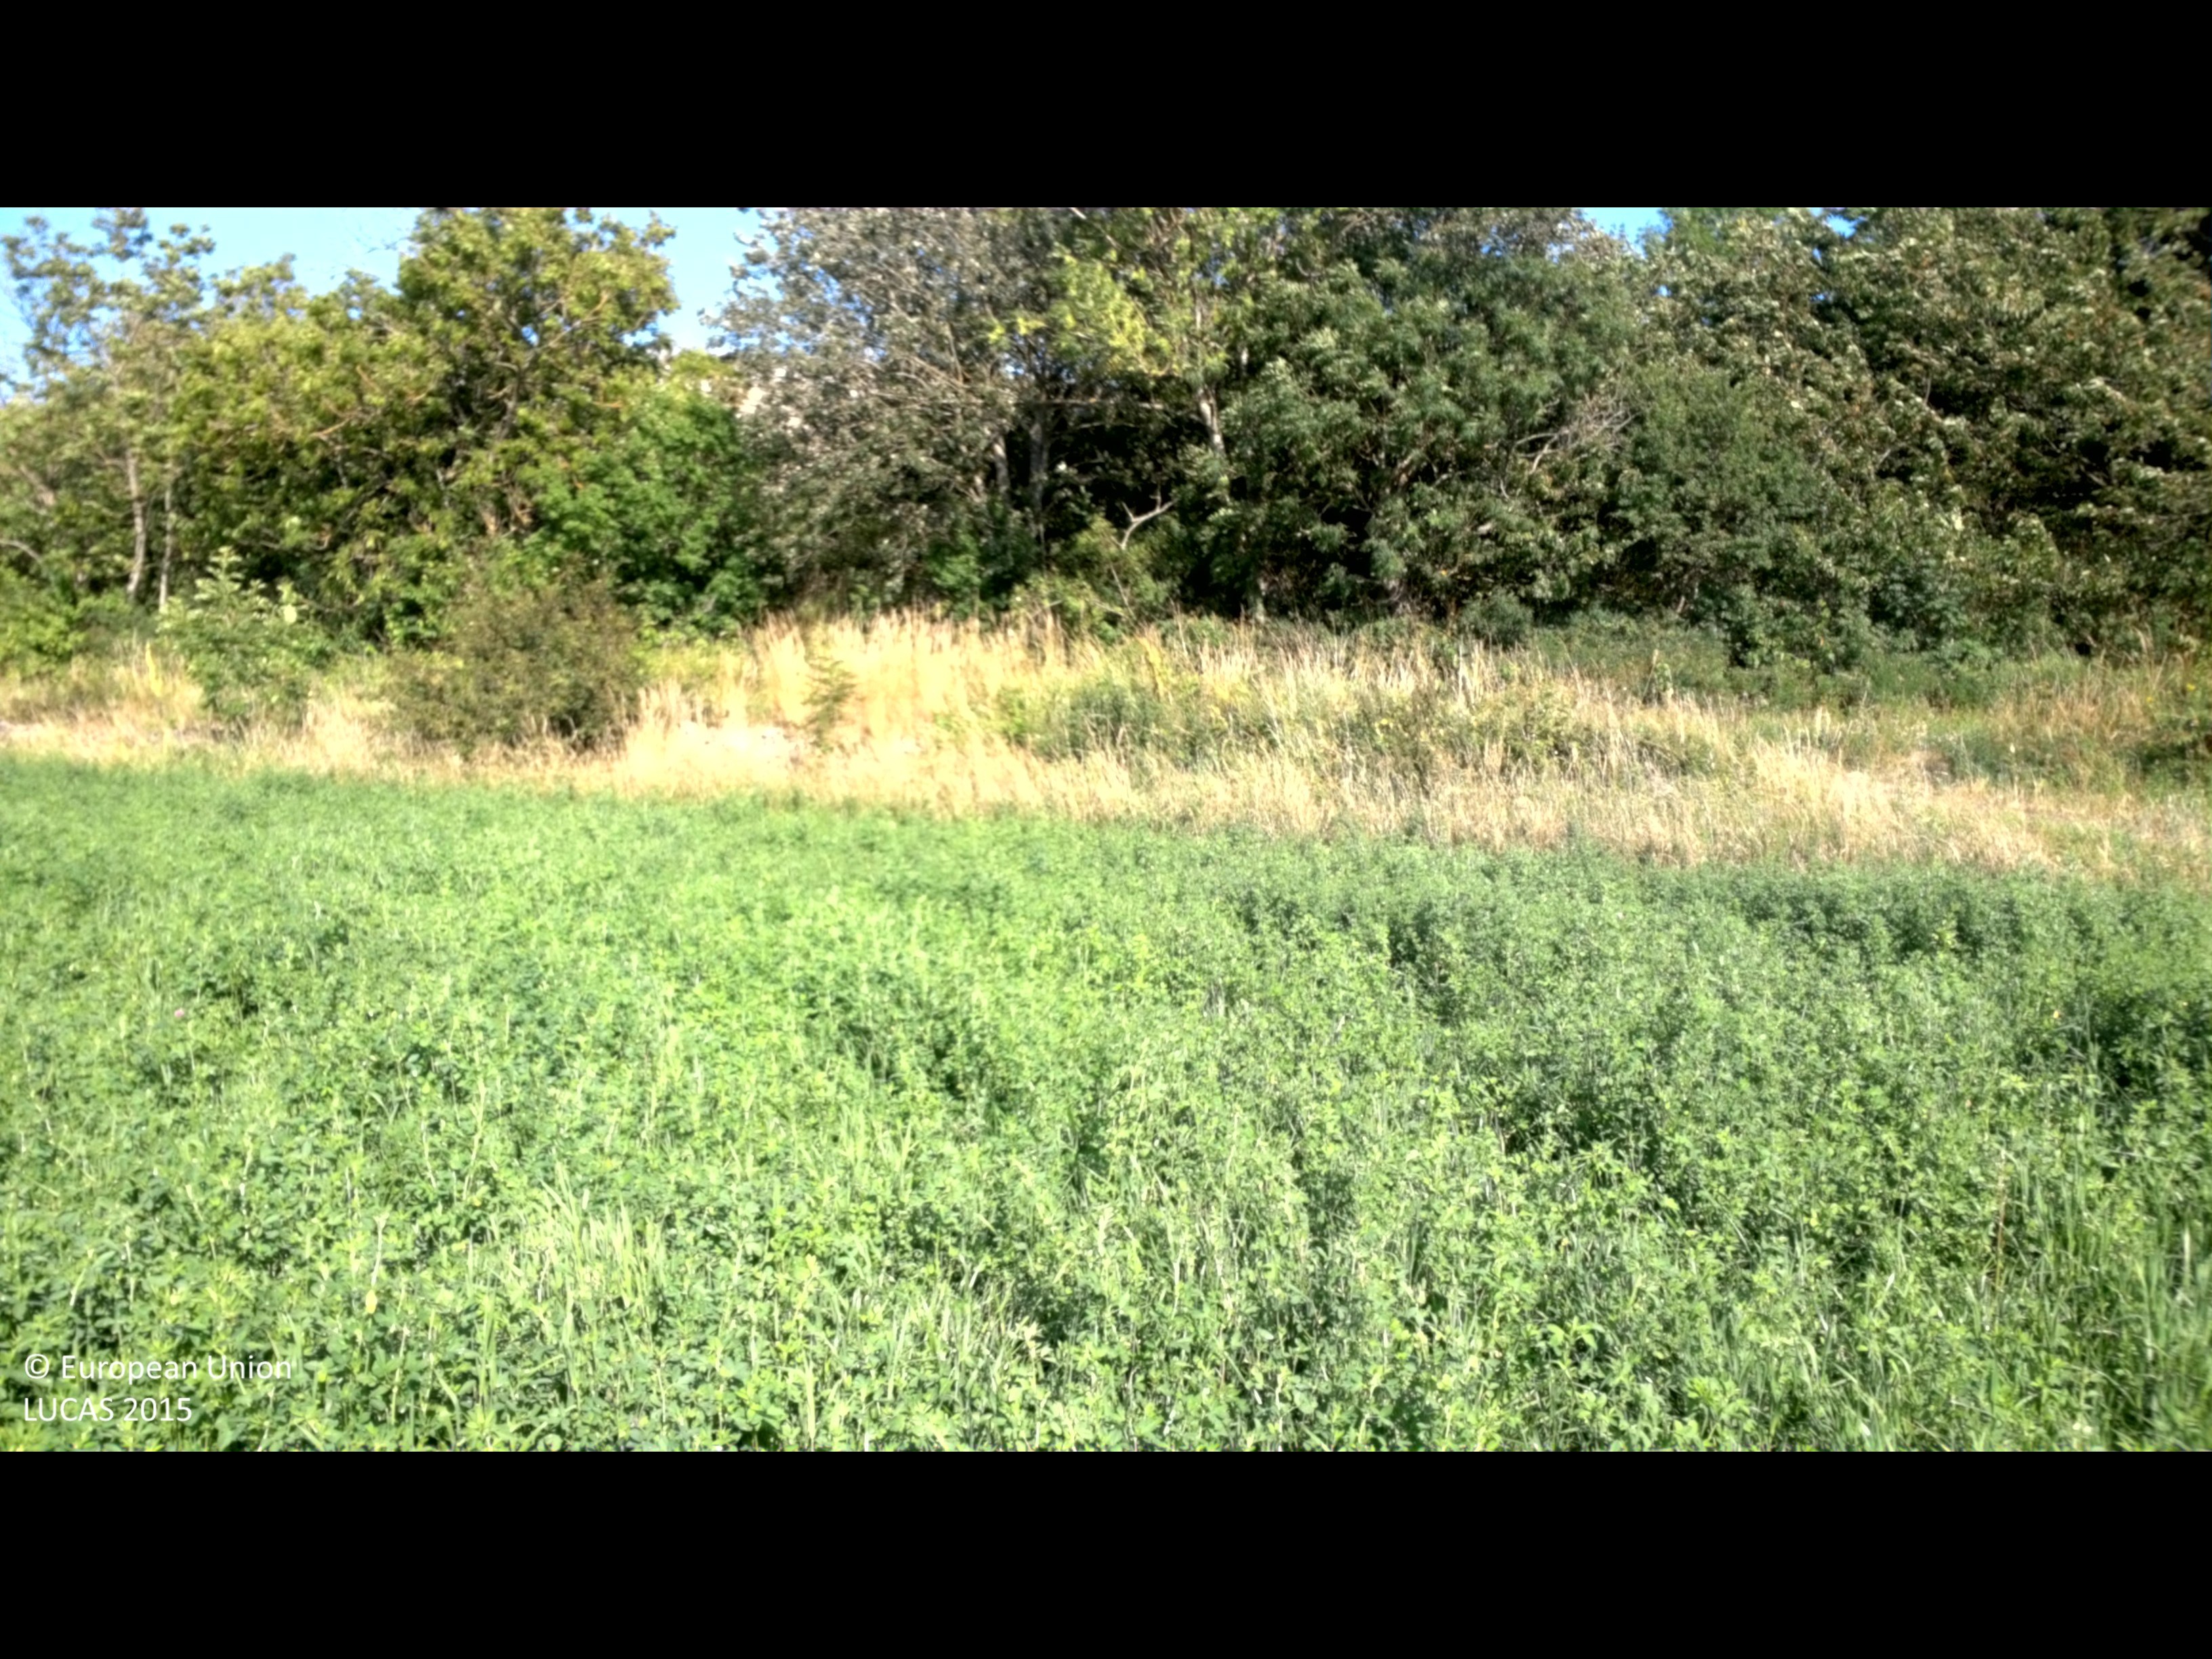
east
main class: Cropland
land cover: Lucerne
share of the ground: > 75 %
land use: Agriculture (excluding fallow land and kitchen gardens)
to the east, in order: Lucerne; Grass margins; Tracks; Broadleaved woodland; Dry stone walls; Grassland with sparse tree/shrub cover; Fences; Grassland without tree/shrub cover; Paved roads, cycling and walking lanes; Grass margins; Dry stone walls; Fences; Grassland with sparse tree/shrub cover
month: July
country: SE
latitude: 56.3873
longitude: 16.4321
